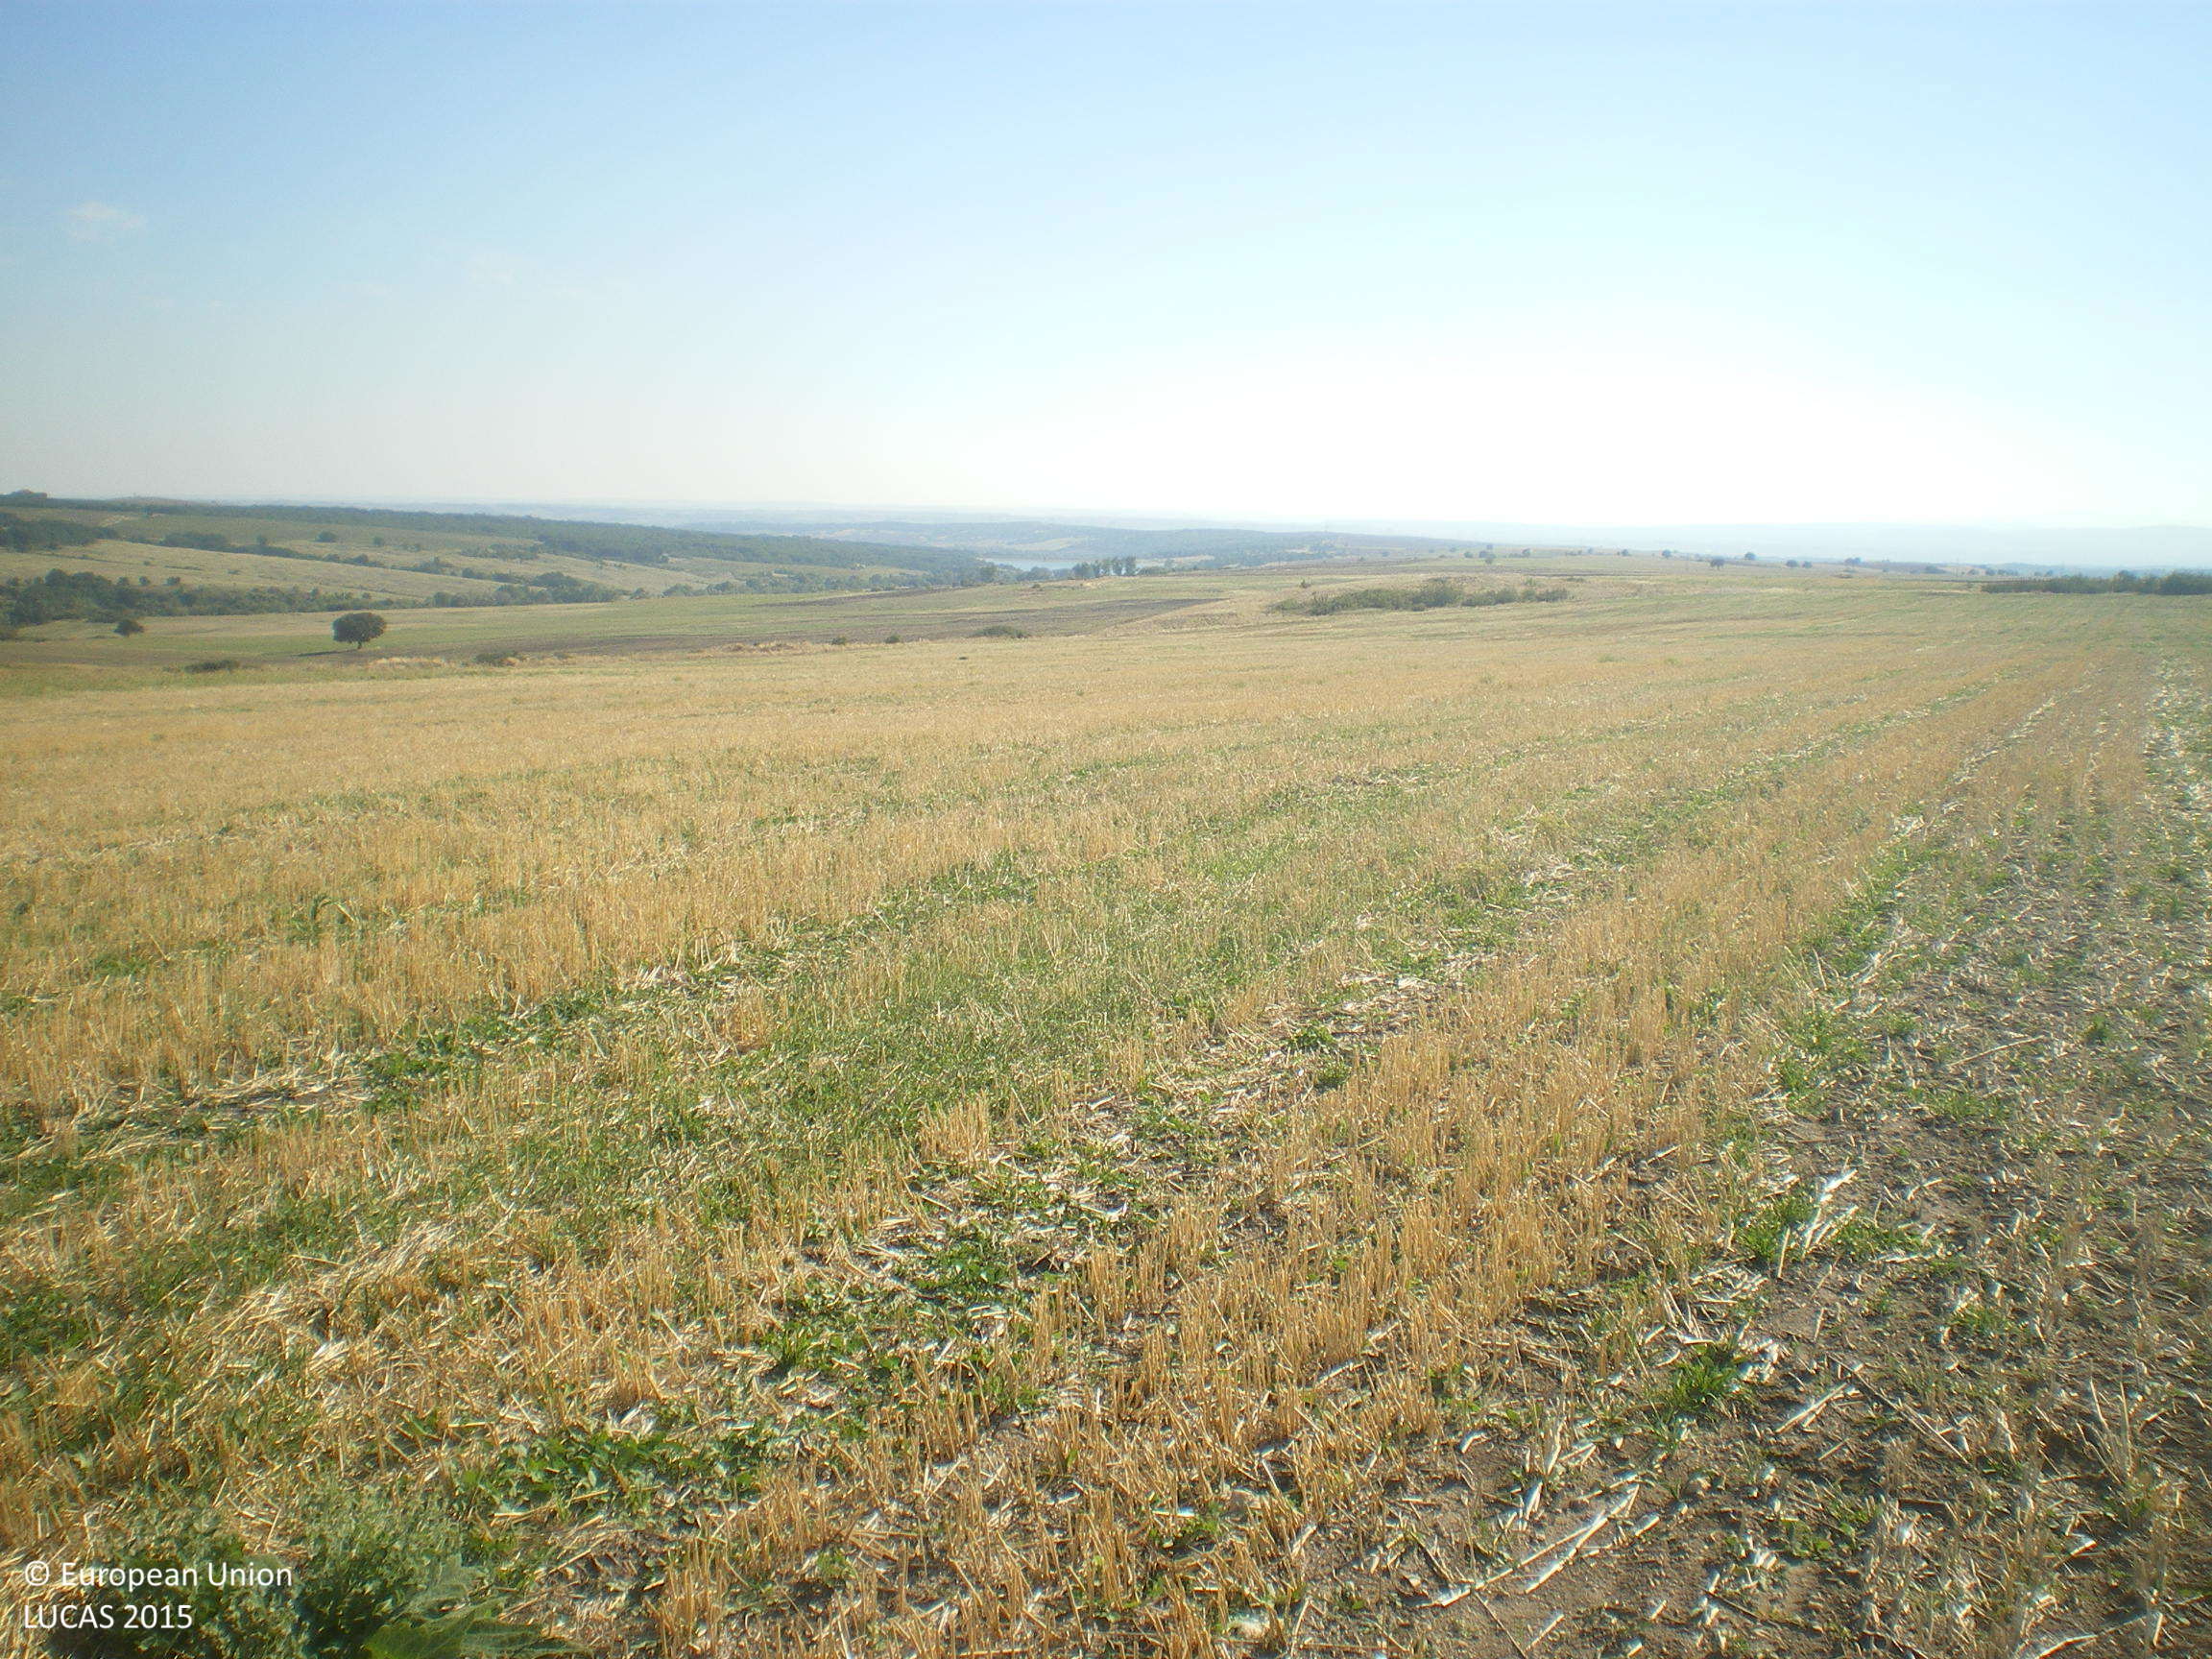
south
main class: Cropland
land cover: Common wheat
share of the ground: 10 - 25 %
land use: Agriculture (excluding fallow land and kitchen gardens)
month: September
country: BG
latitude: 41.8342
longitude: 26.3235
